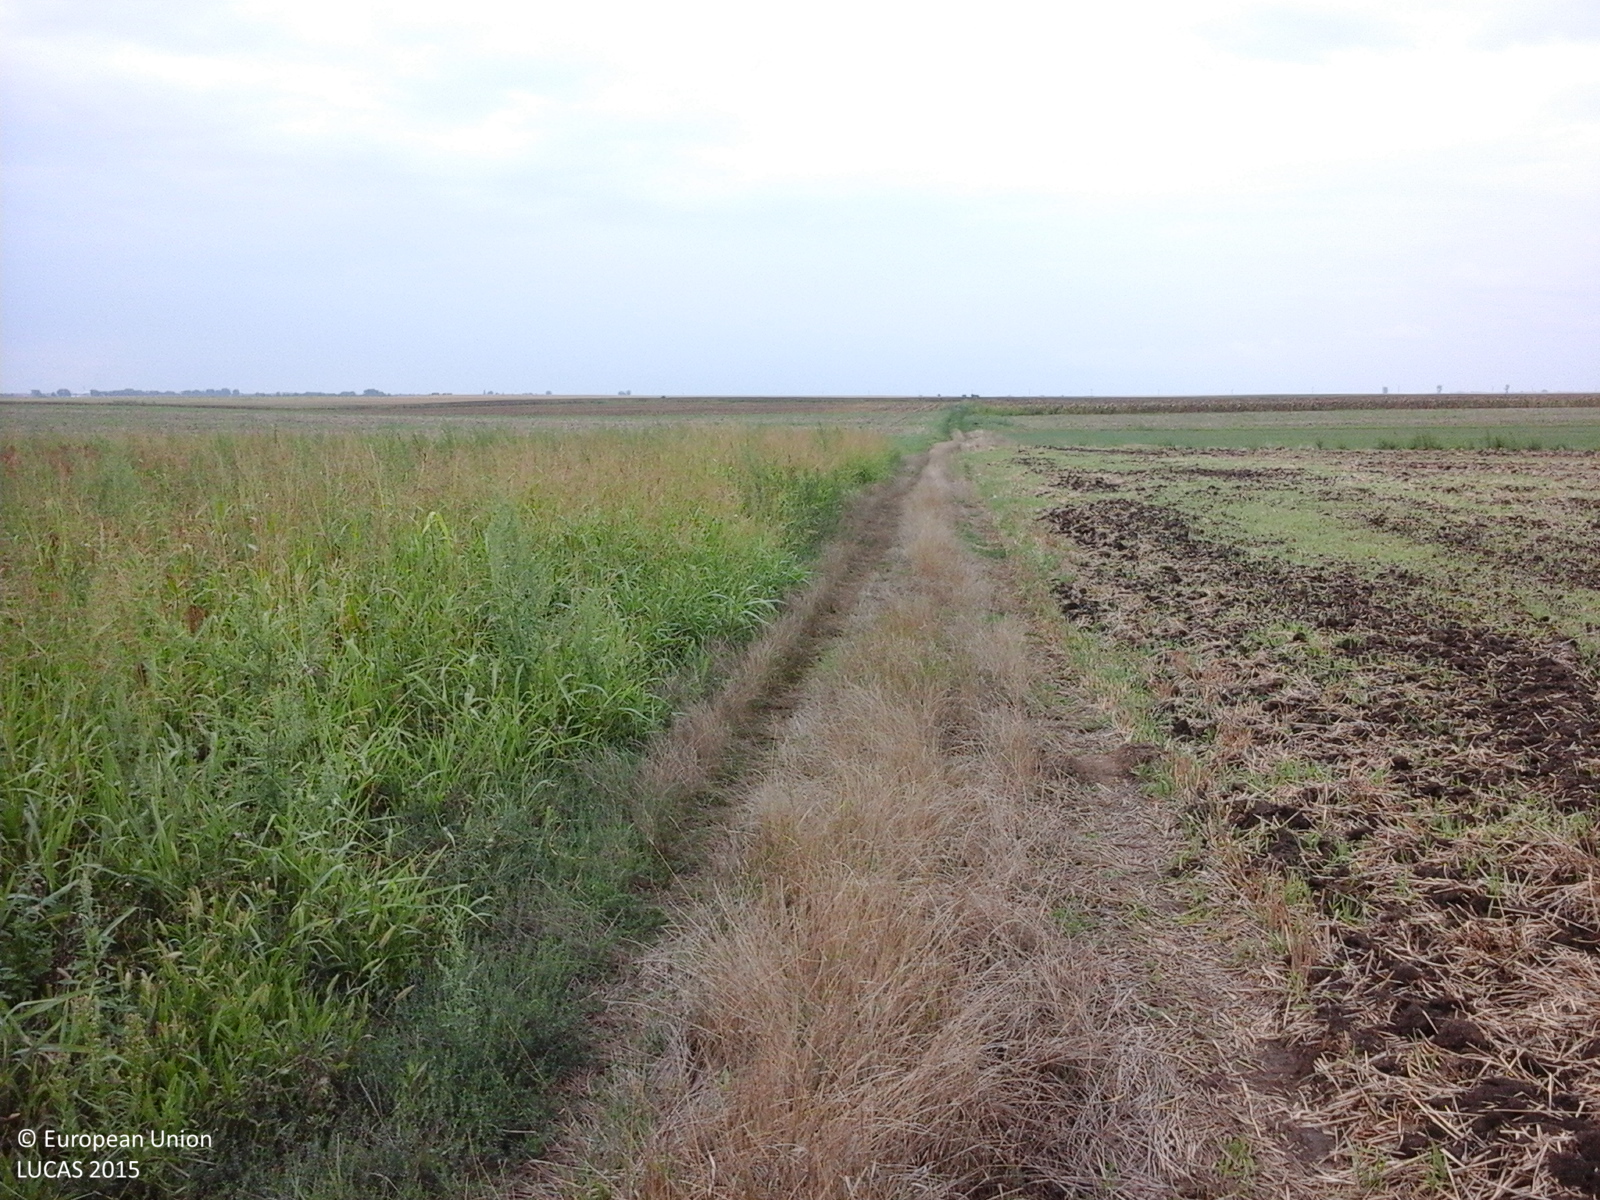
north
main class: Cropland
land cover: Sunflower
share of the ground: > 75 %
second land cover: Spontaneously vegetated surfaces
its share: 50 - 75 %
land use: Agriculture (excluding fallow land and kitchen gardens)
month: August
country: RO
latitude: 45.9654
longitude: 20.9848
